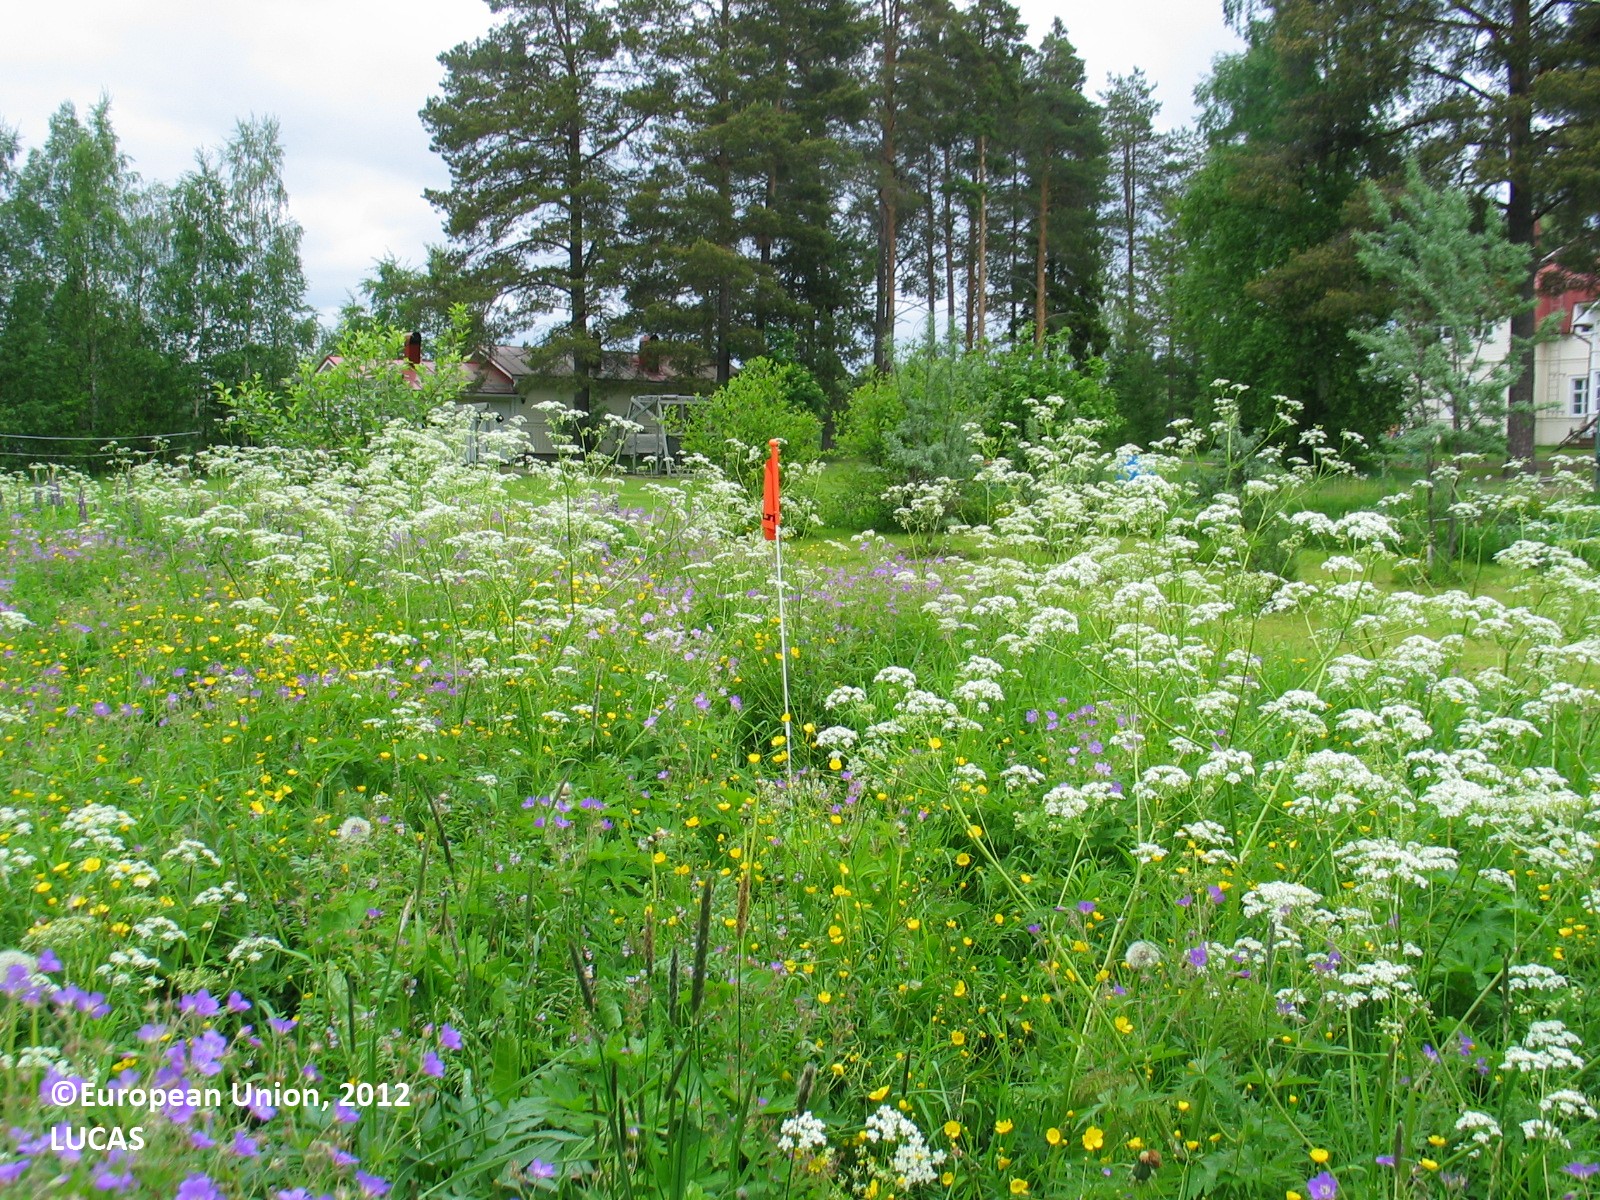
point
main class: Grassland
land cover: Grassland without tree/shrub cover
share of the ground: > 75 %
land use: Residential
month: June
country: FI
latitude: 65.1935
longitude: 25.3951
